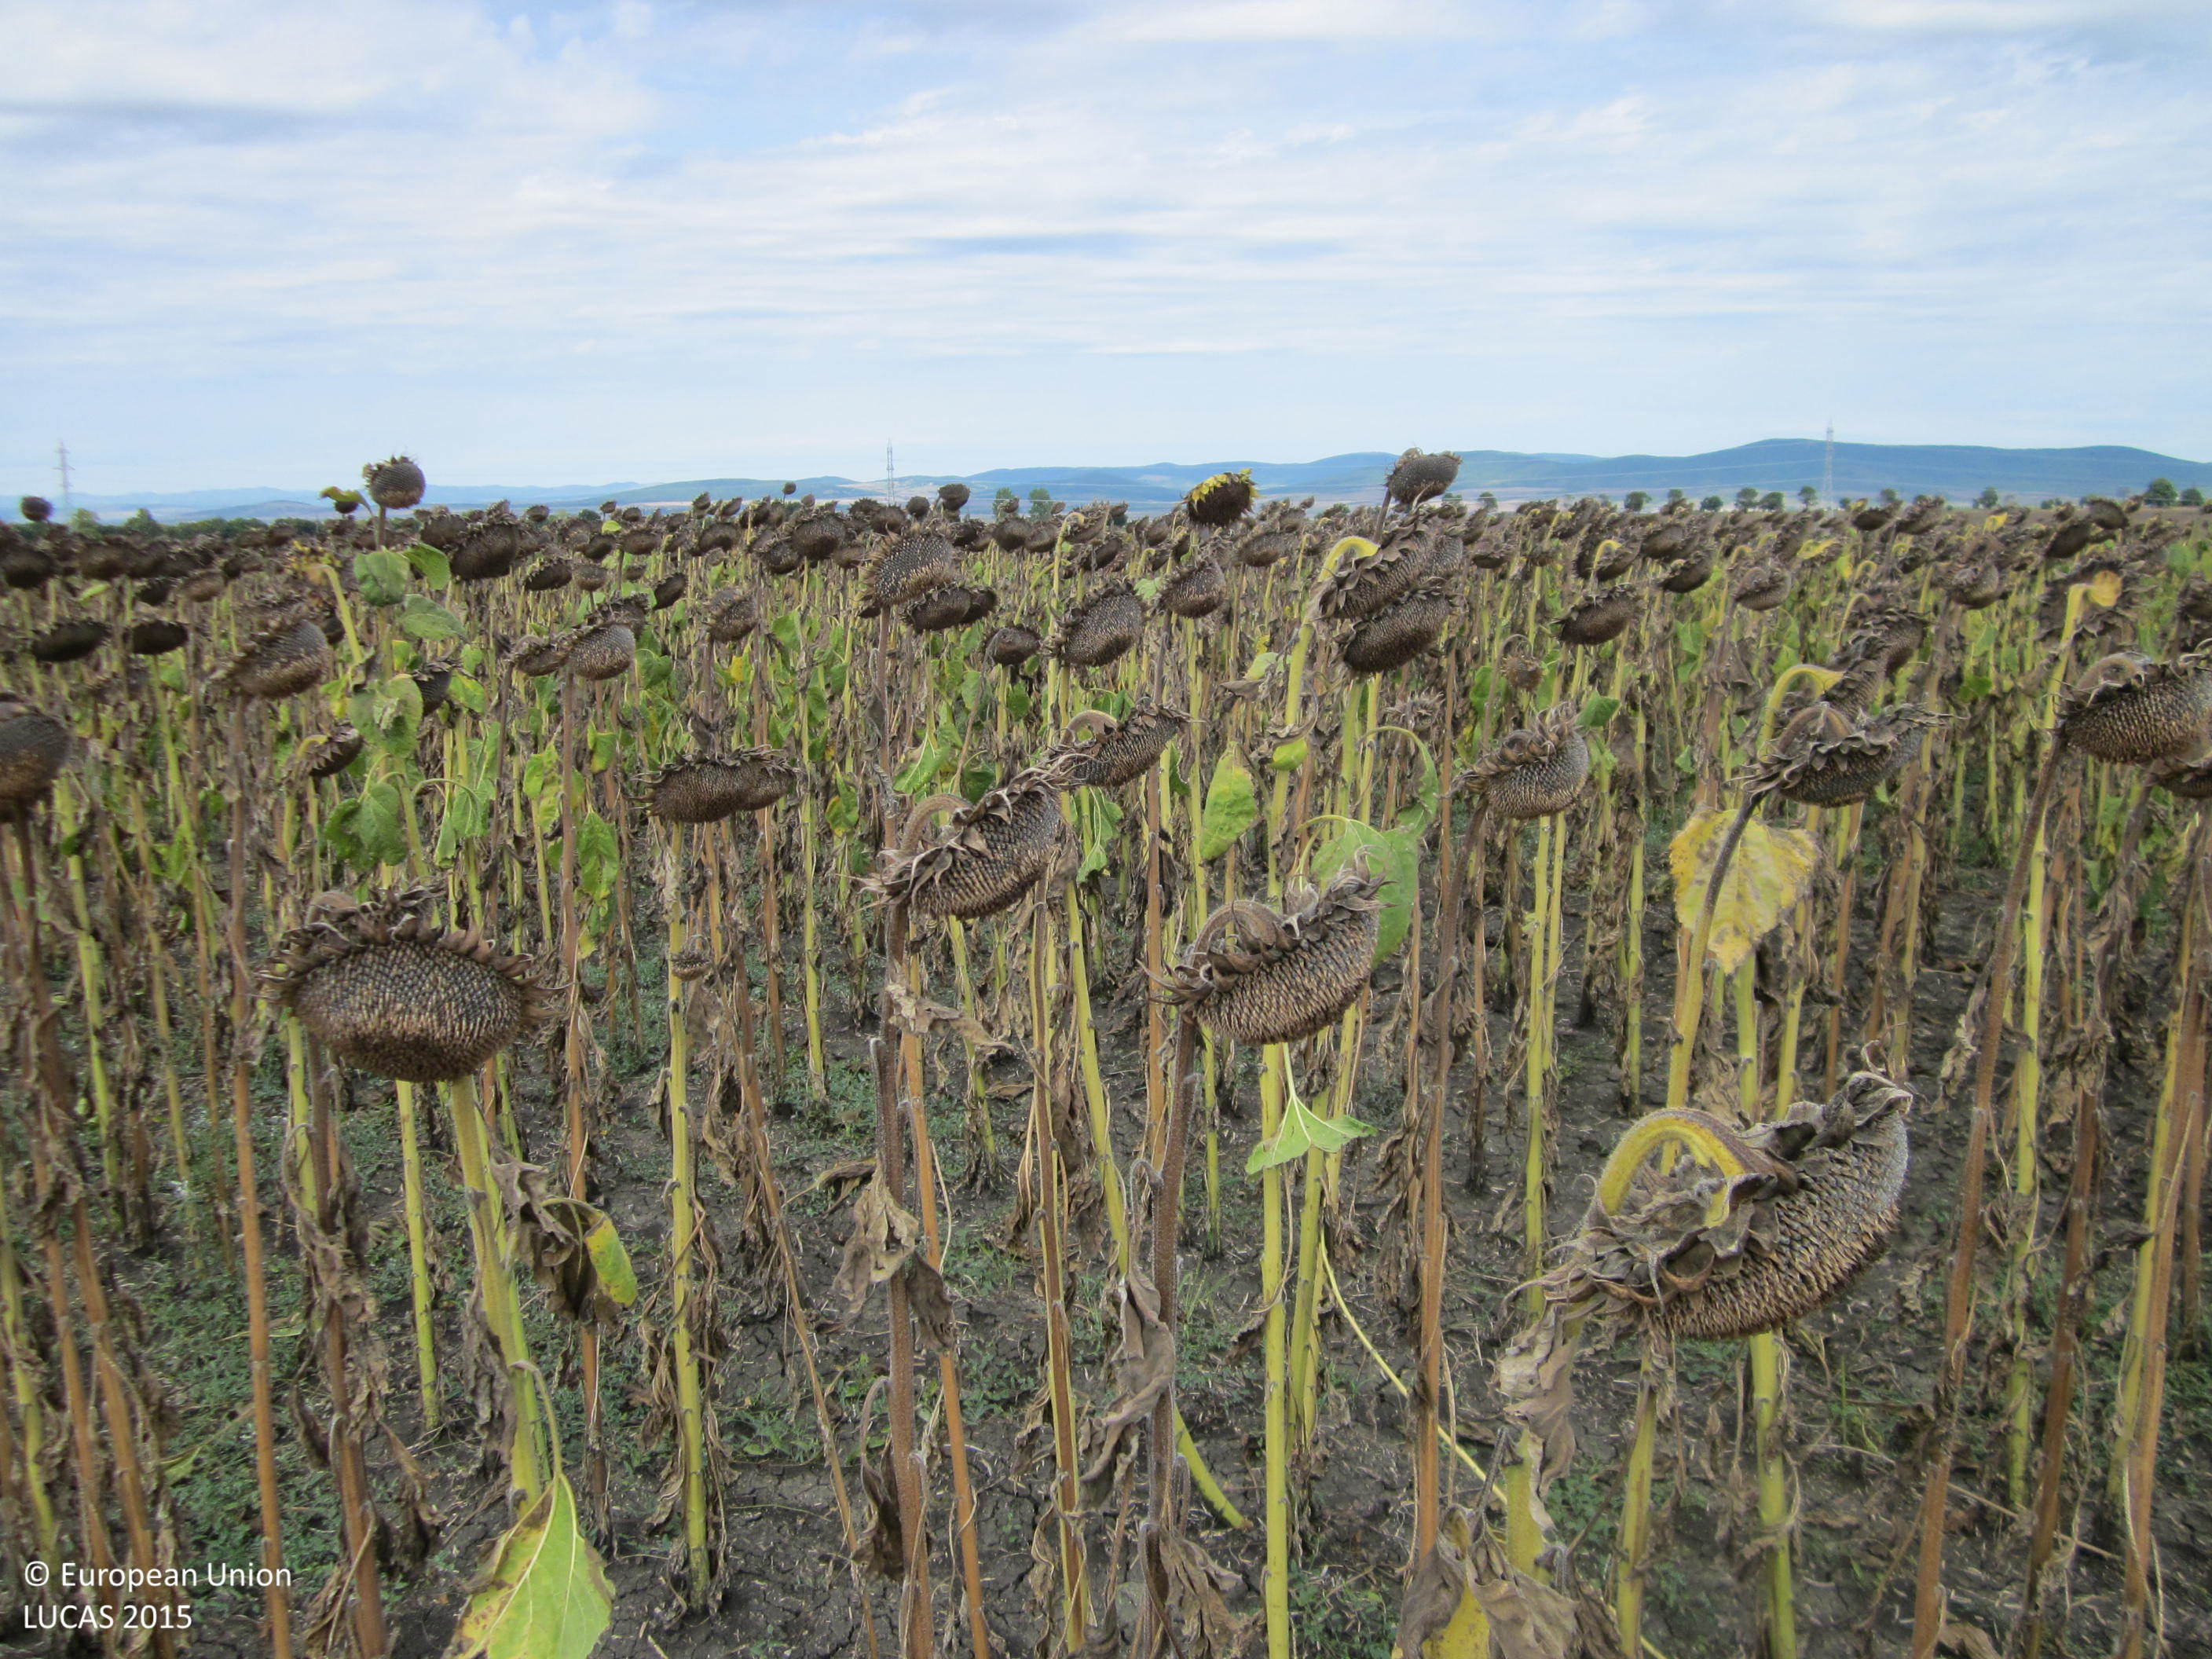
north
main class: Cropland
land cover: Sunflower
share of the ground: > 75 %
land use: Agriculture (excluding fallow land and kitchen gardens)
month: September
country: BG
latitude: 42.6546
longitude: 27.0269
